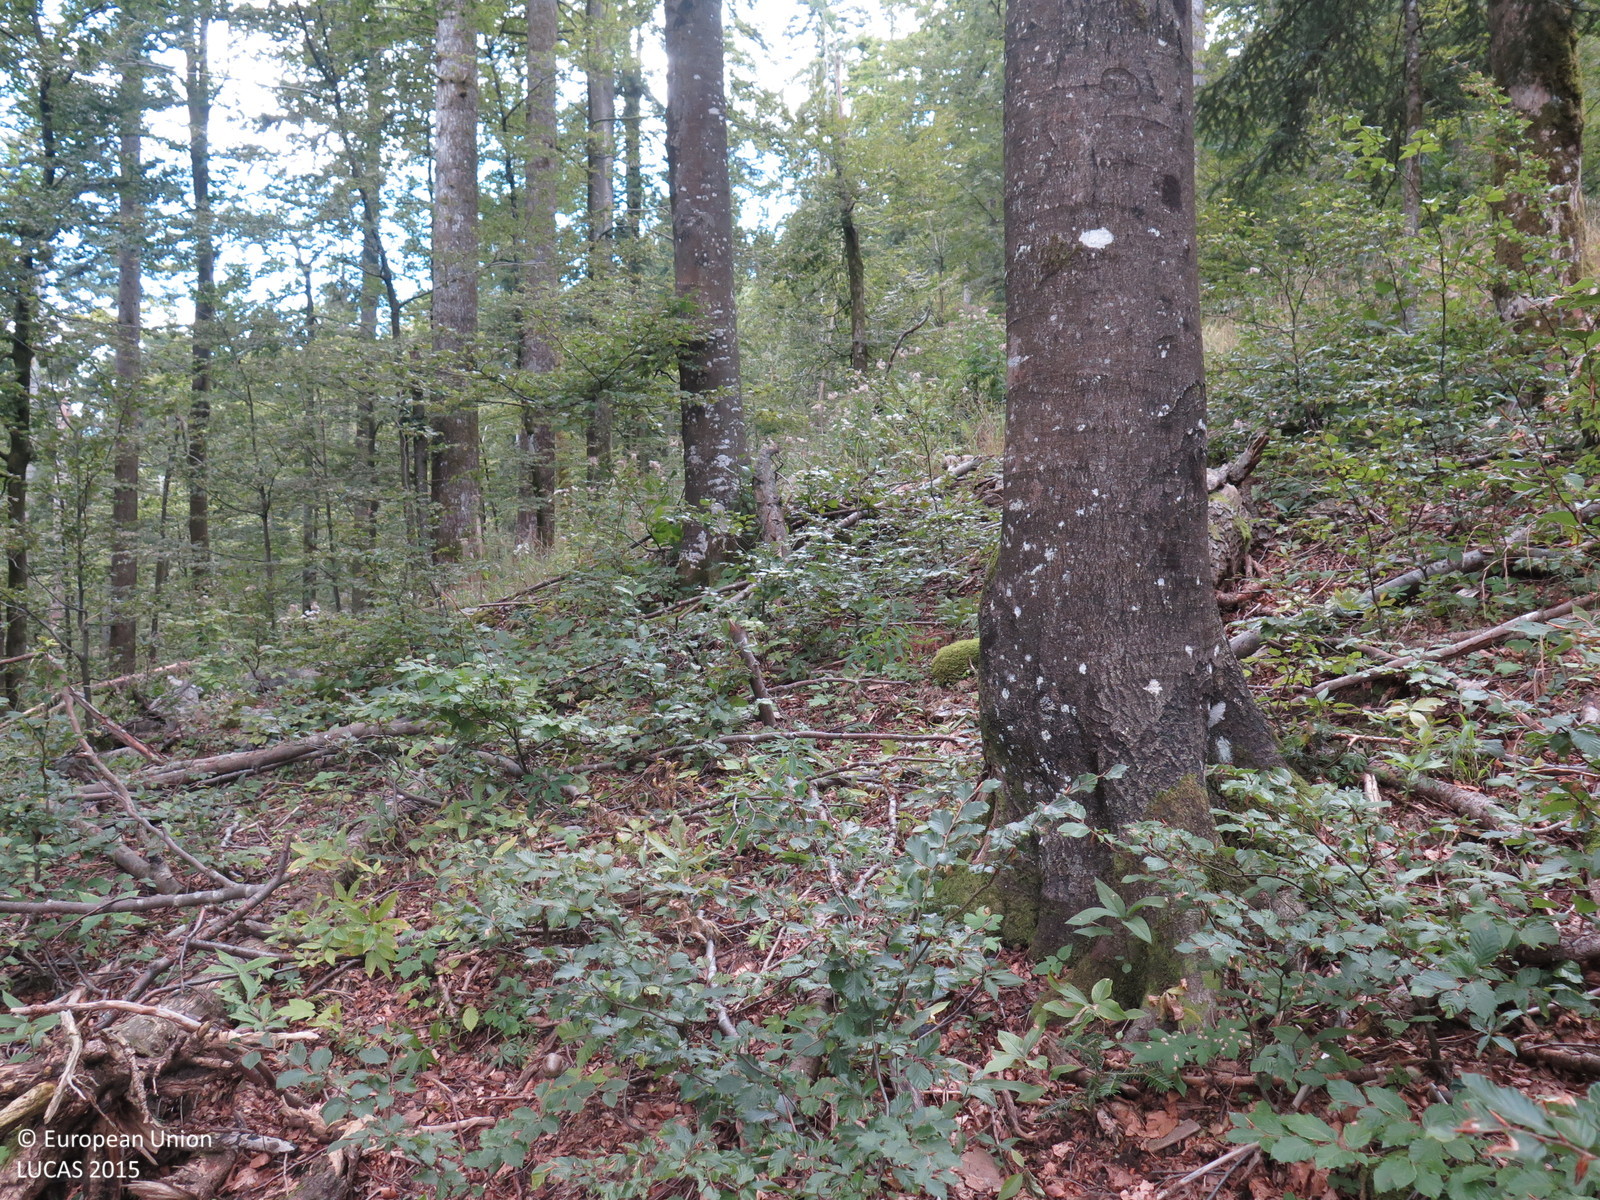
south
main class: Woodland
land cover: Other mixed woodland
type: mountainous beech forest
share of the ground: > 75 %
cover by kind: broadleaved forest trees 75 %, coniferous forest trees 25 %
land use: Forestry
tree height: > 5 m
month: September
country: HR
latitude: 45.3791
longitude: 14.7585
